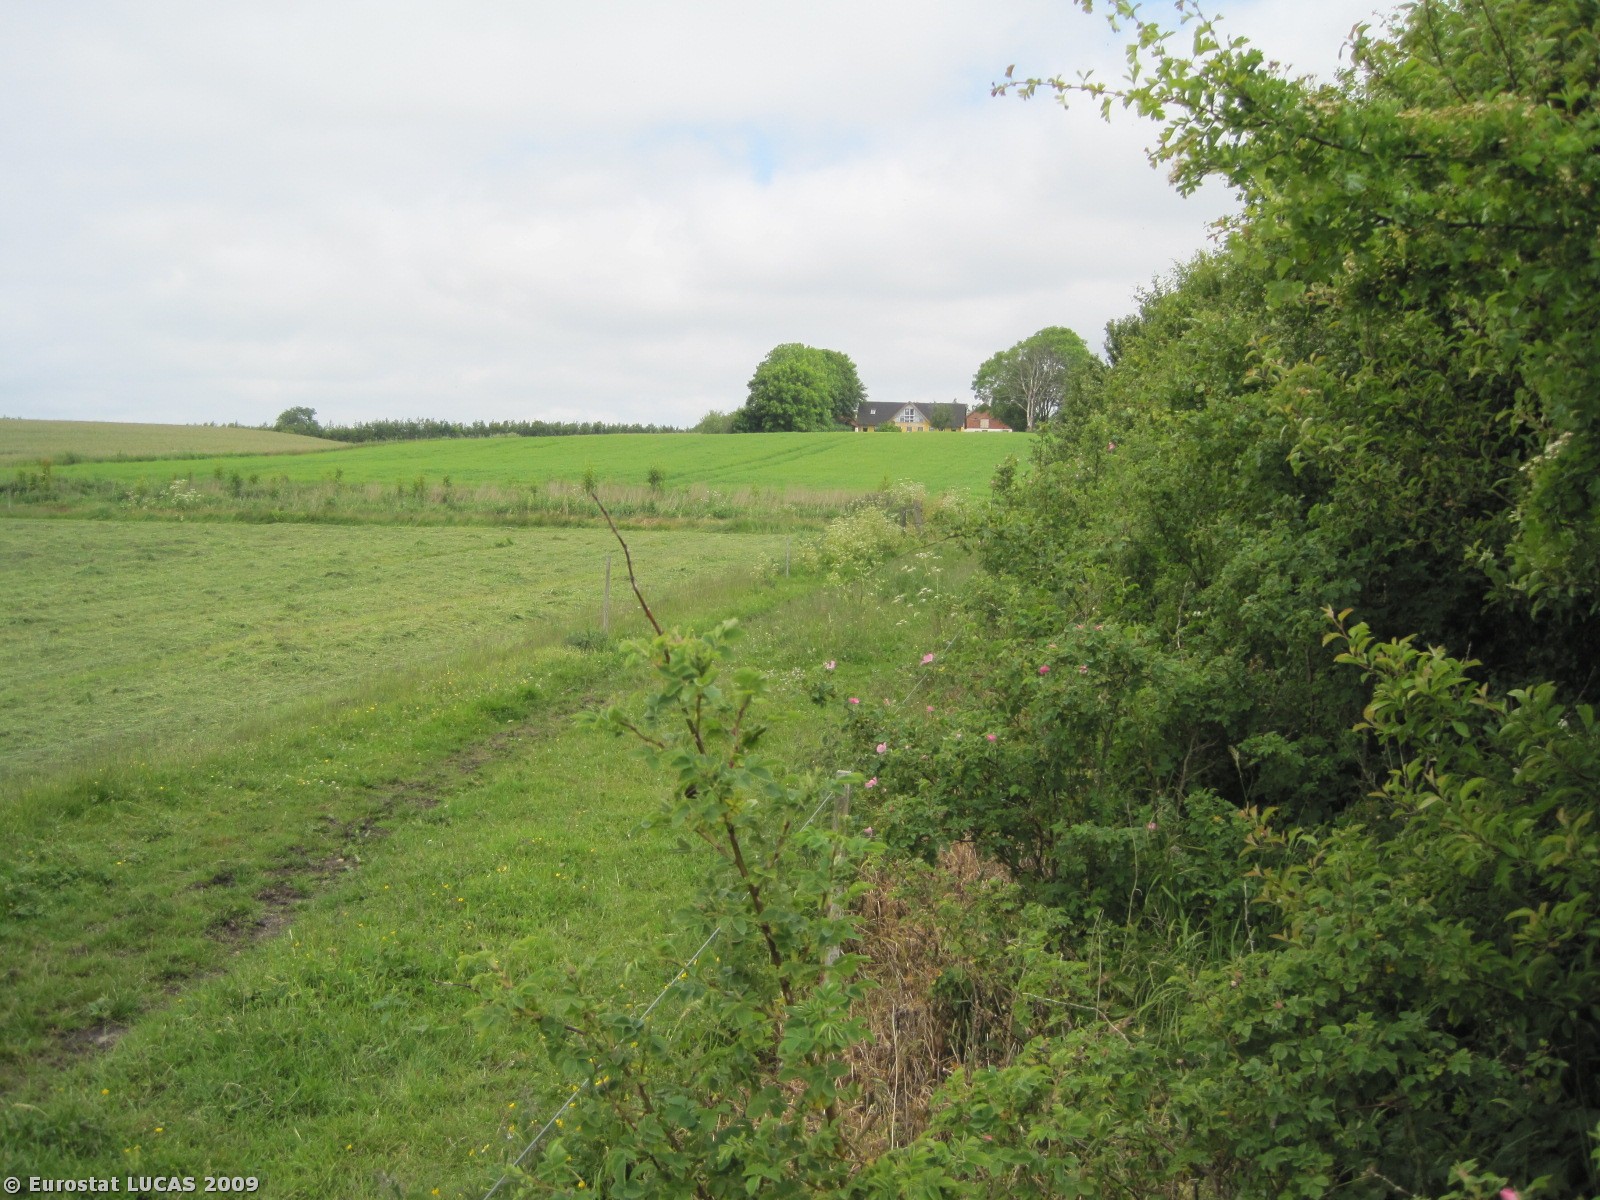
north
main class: Grassland
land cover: Grassland without tree/shrub cover
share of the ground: > 75 %
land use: Agriculture (excluding fallow land and kitchen gardens)
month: June
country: DK
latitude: 57.2483
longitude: 10.1489
